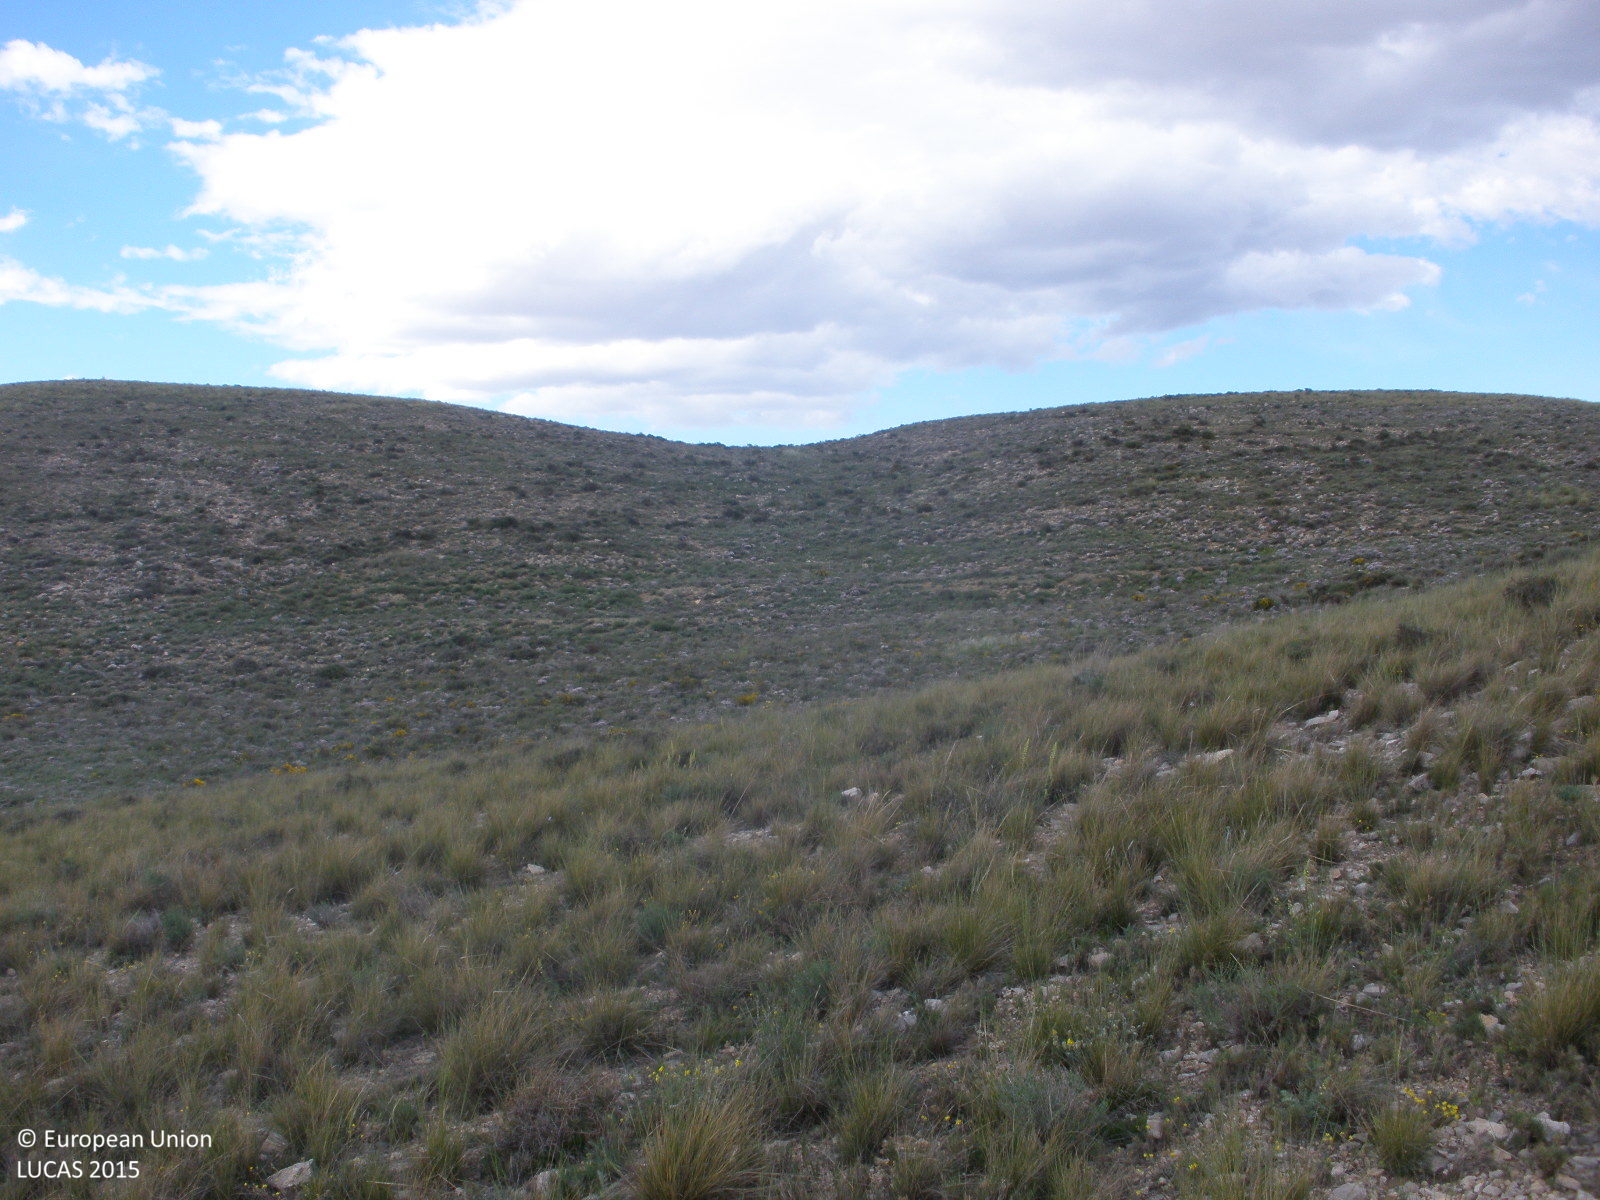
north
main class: Shrubland
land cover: Shrubland without tree cover
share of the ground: 25 - 50 %
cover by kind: herbaceous plants 40 %, shrubs 30 %, consolidated bare surface 30 %
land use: Agriculture (excluding fallow land and kitchen gardens)
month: May
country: ES
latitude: 41.0438
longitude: -0.9014
